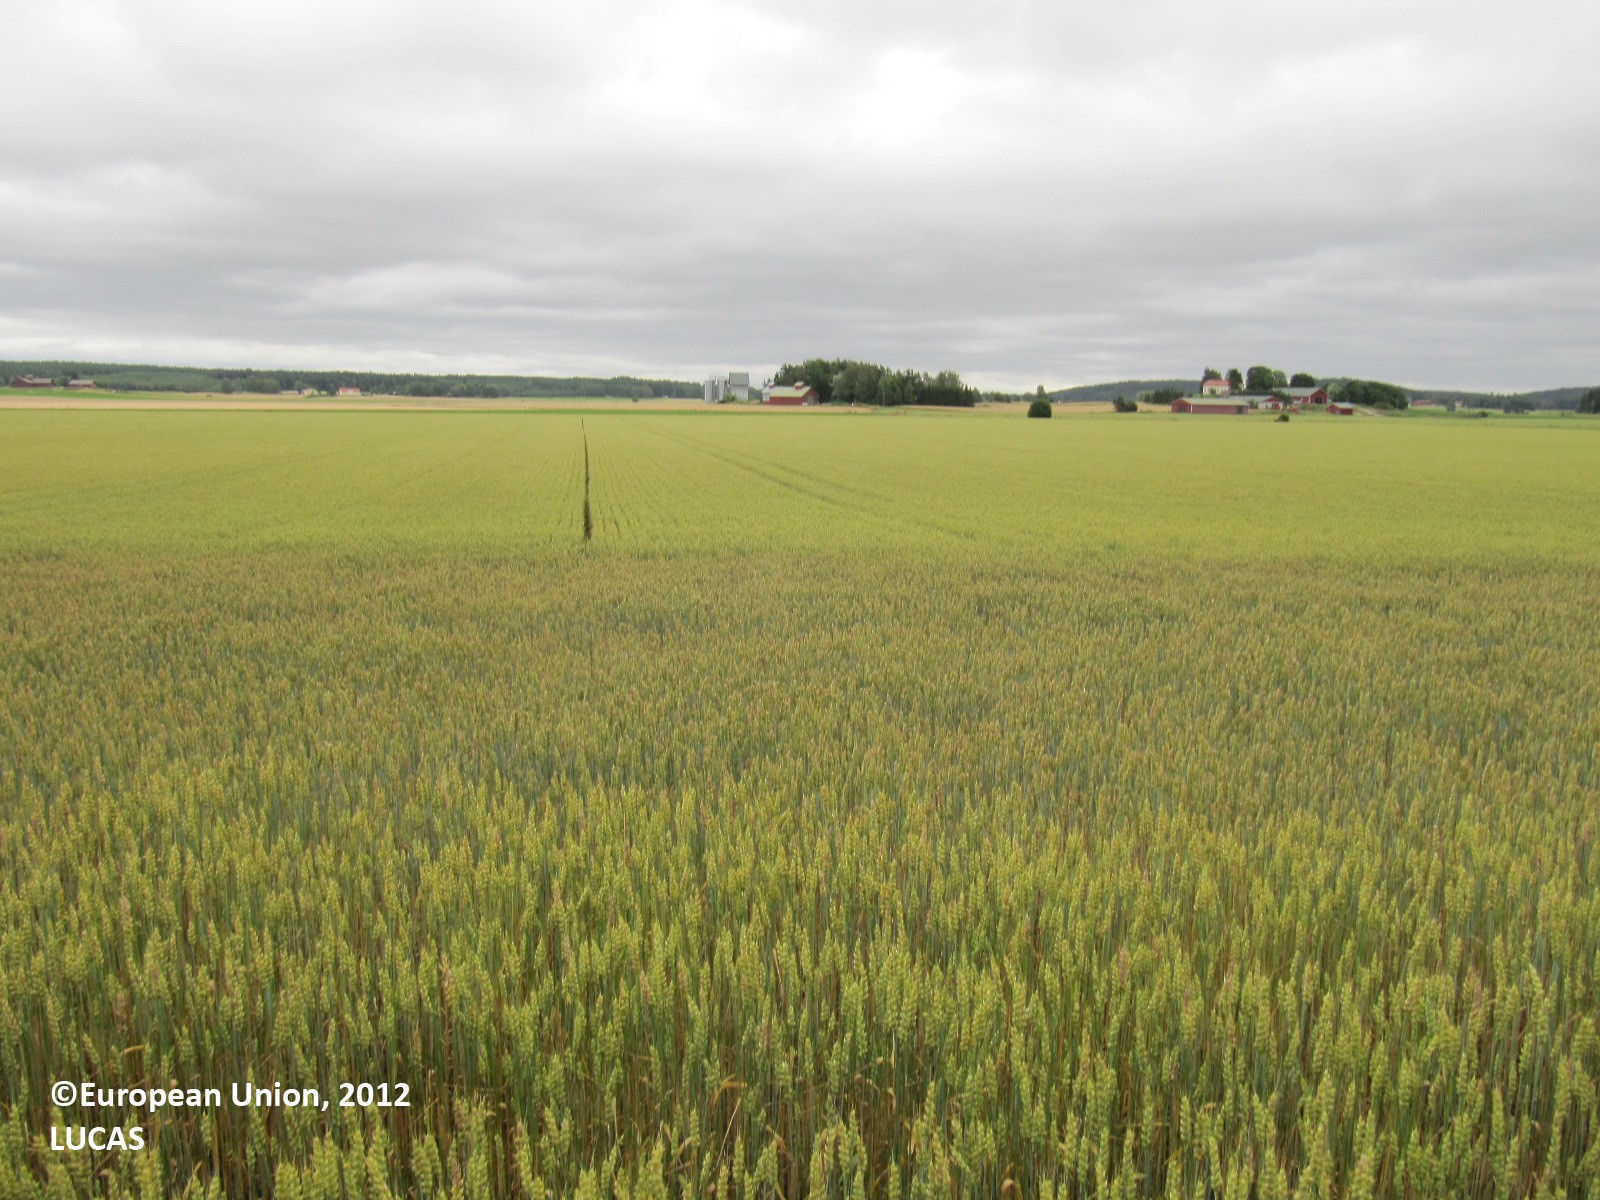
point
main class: Cropland
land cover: Common wheat
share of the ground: > 75 %
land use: Agriculture (excluding fallow land and kitchen gardens)
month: August
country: FI
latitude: 60.1575
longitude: 23.0343
